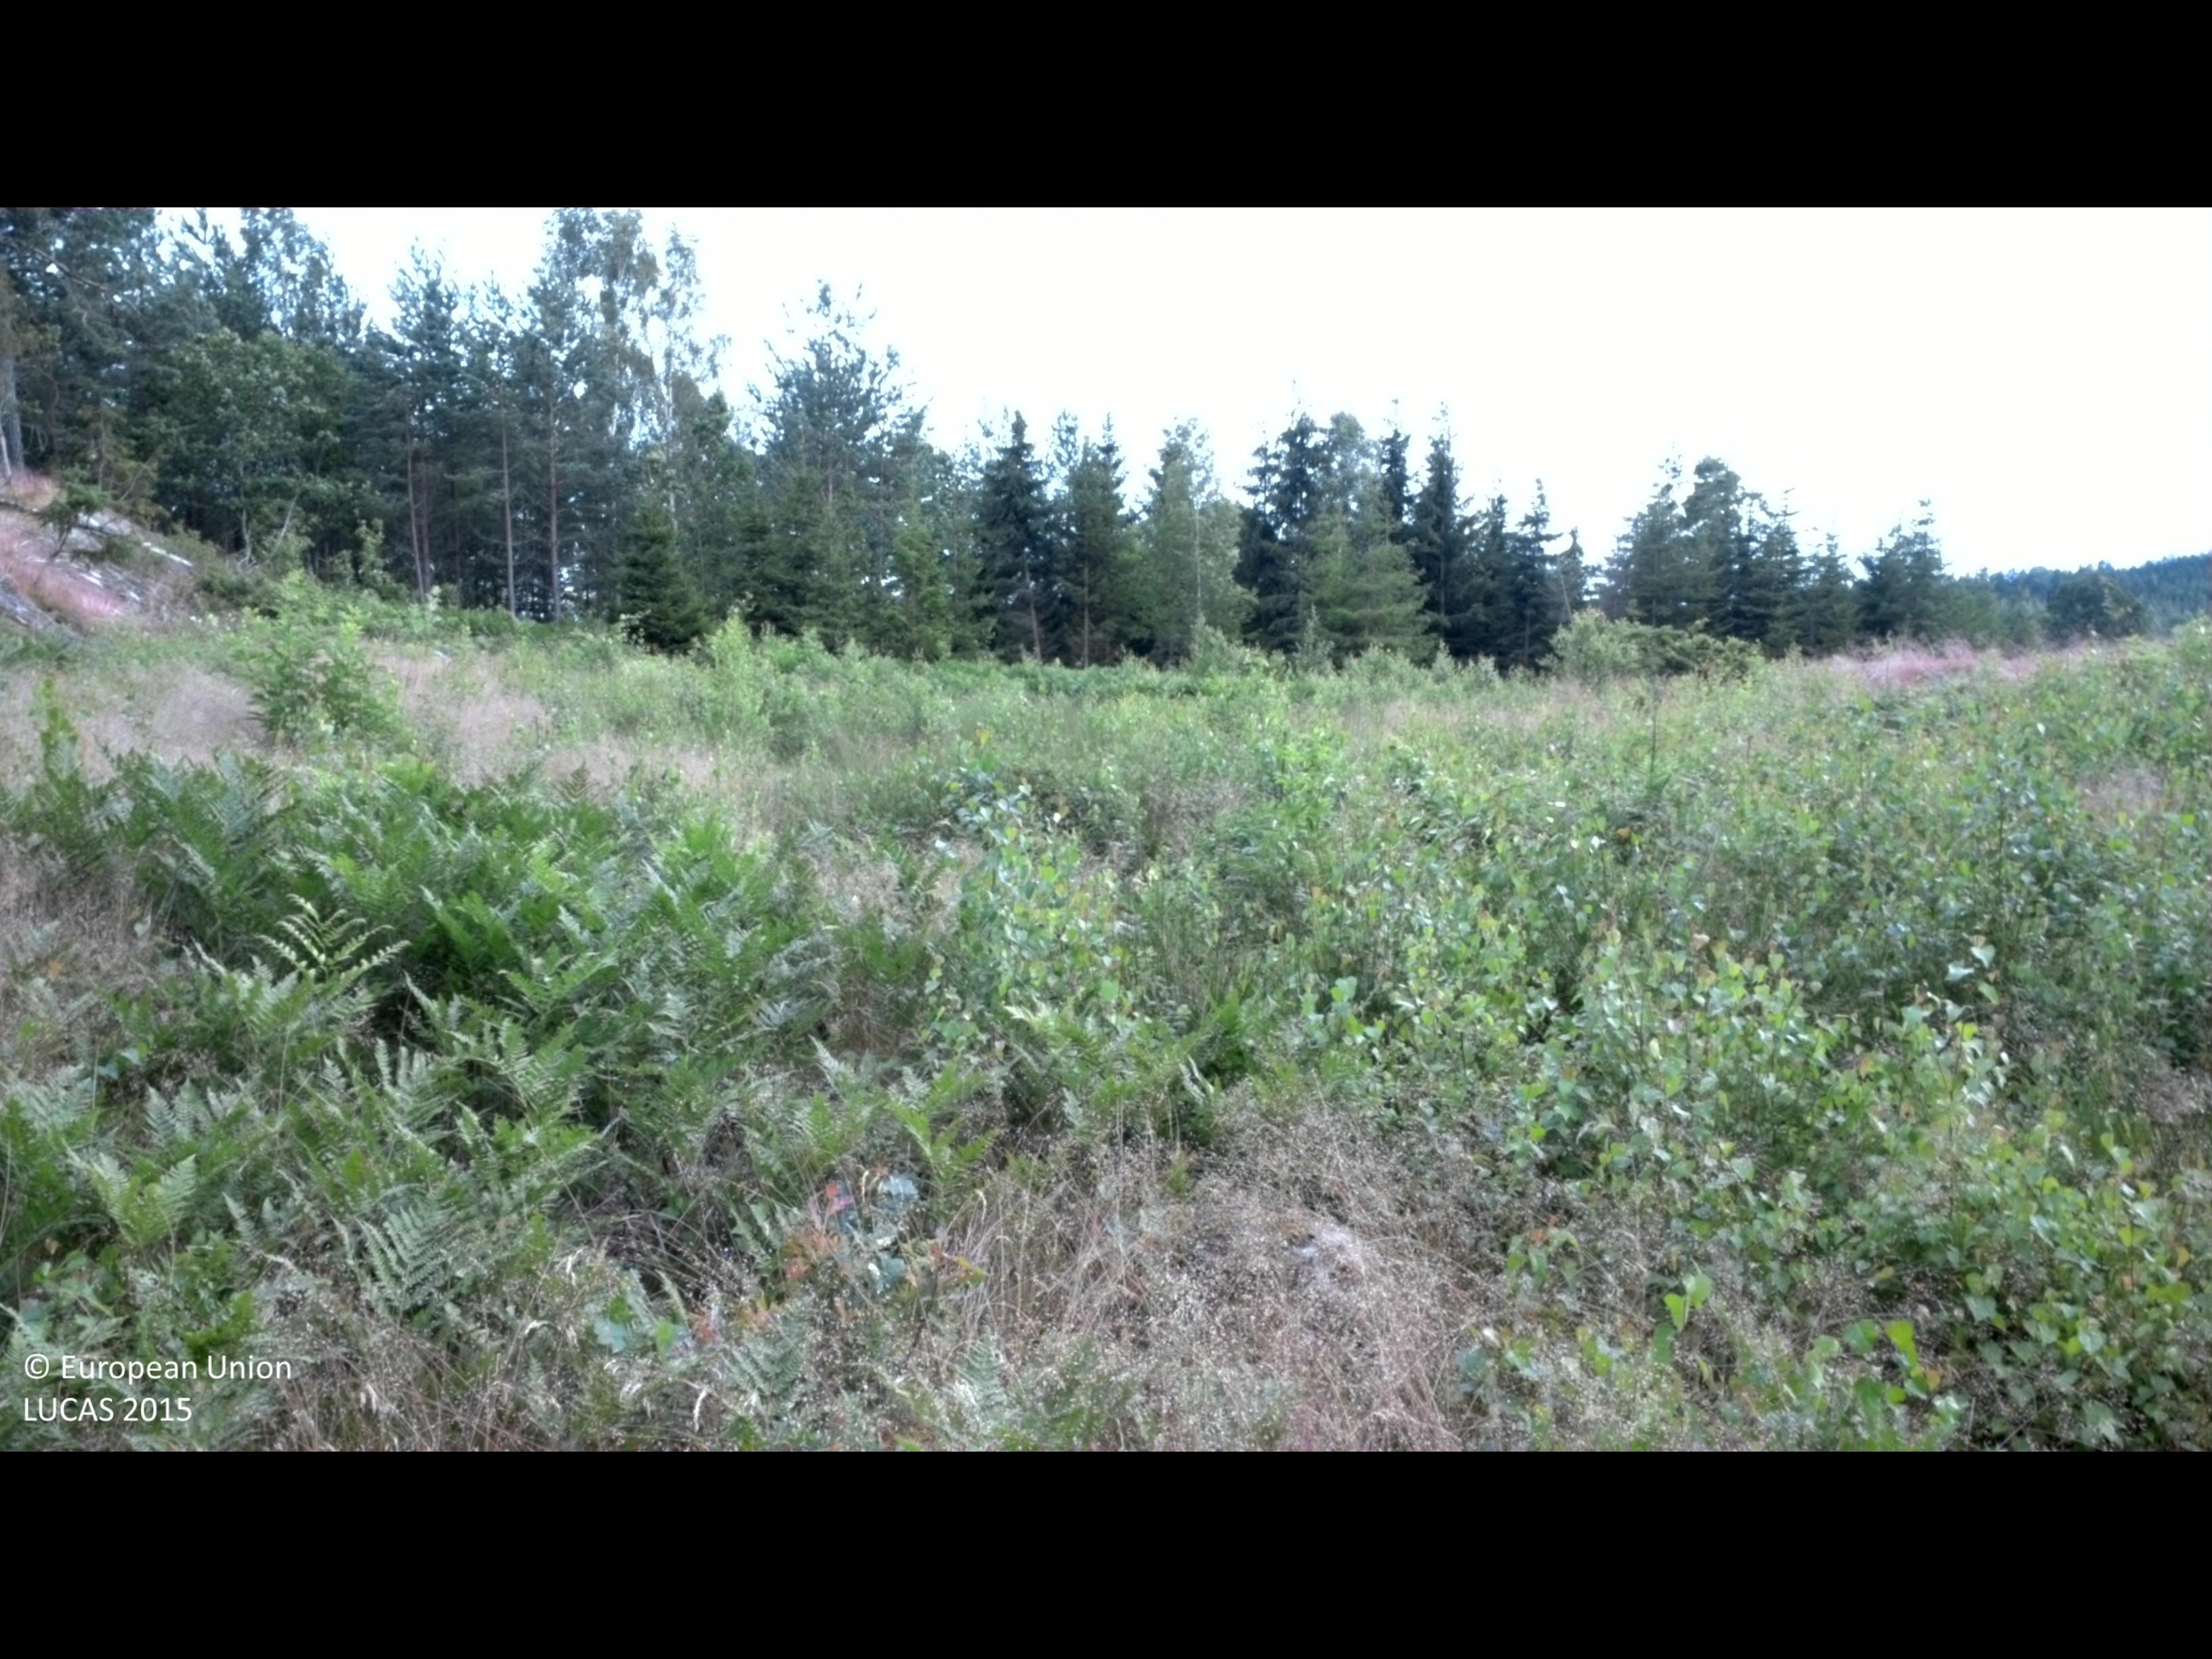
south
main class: Woodland
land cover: Broadleaved woodland
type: boreal forest
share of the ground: 10 - 25 %
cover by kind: herbaceous plants 60 %, broadleaved forest trees 20 %, shrubs 10 %, lichens and mosses 10 %
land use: Forestry
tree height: < 5 m
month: July
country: SE
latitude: 58.1051
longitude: 16.3604
